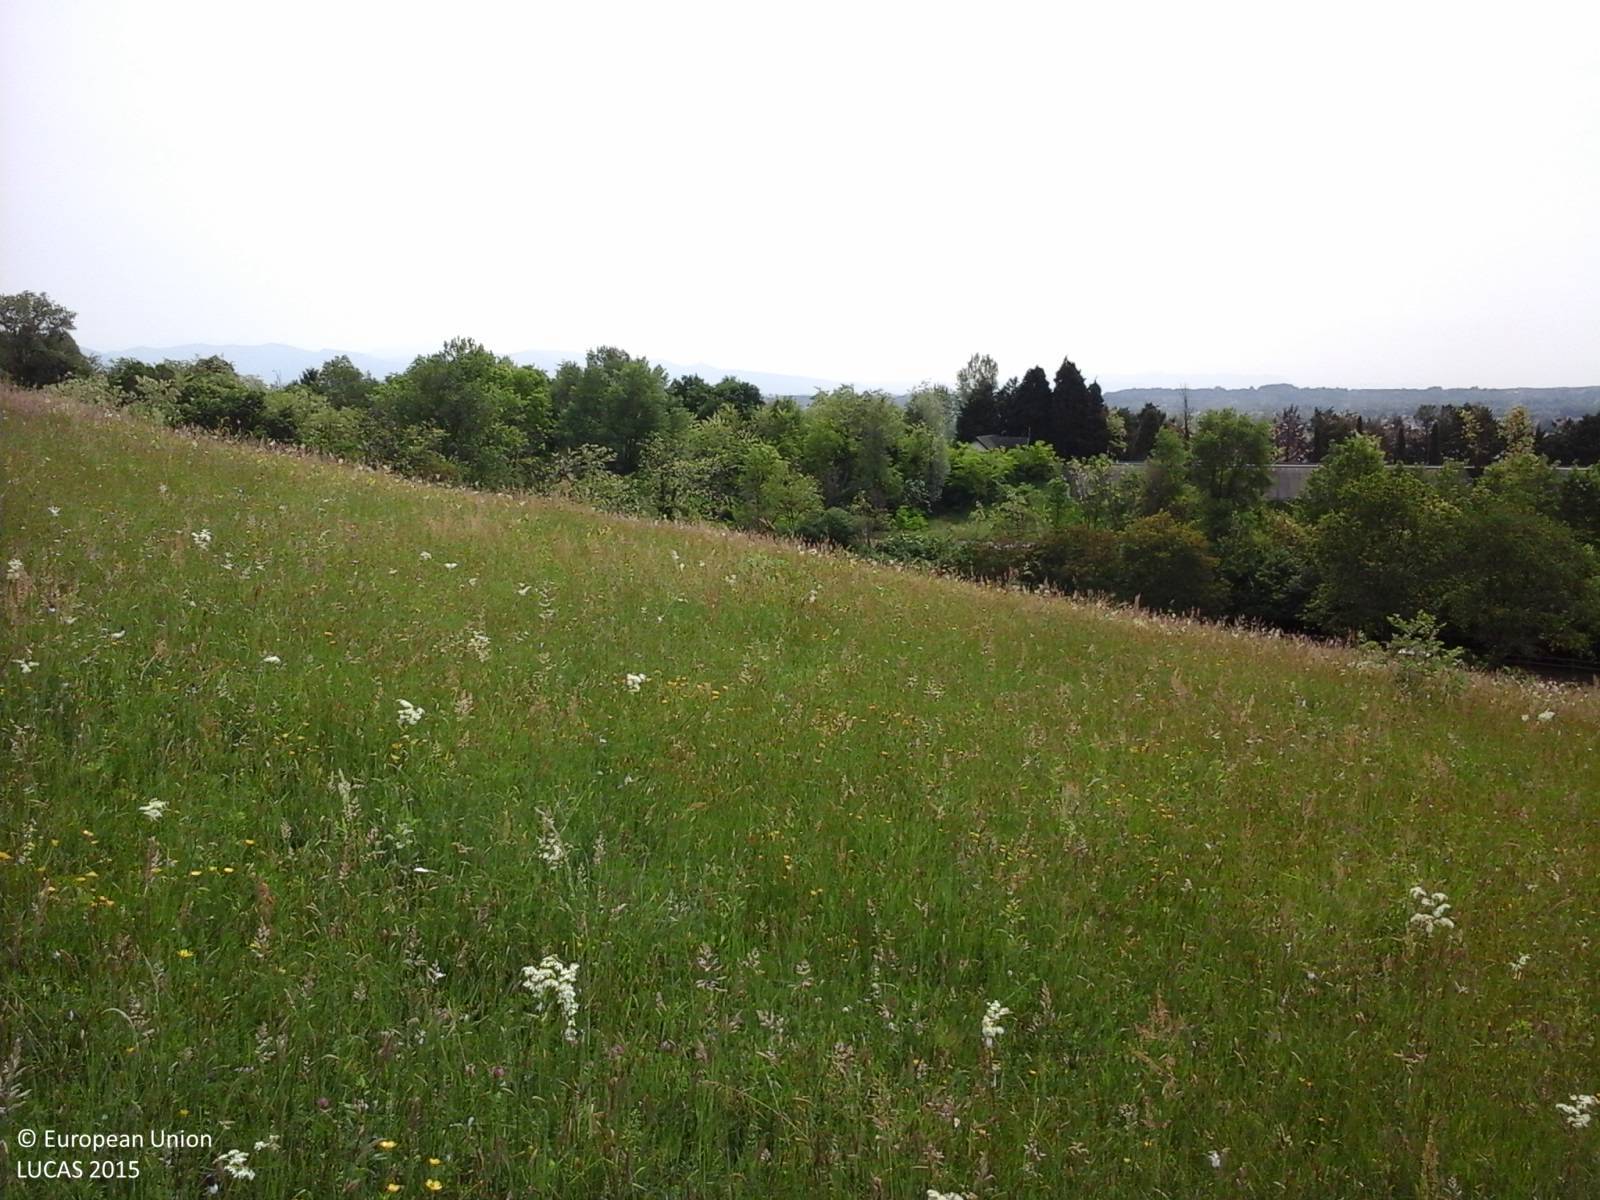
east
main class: Grassland
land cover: Grassland without tree/shrub cover
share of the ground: > 75 %
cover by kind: herbaceous plants 100 %
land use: Agriculture (excluding fallow land and kitchen gardens)
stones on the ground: < 10 %
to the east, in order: Grassland without tree/shrub cover; Fences; Grassland with sparse tree/shrub cover; Broadleaved woodland; Inland fresh running water; Broadleaved woodland; Grassland with sparse tree/shrub cover; Grass margins; Paved roads, cycling and walking lanes; Grass margins; Broadleaved woodland; Inland fresh running water; Broadleaved woodland
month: May
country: IT
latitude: 46.1818
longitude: 13.0411
